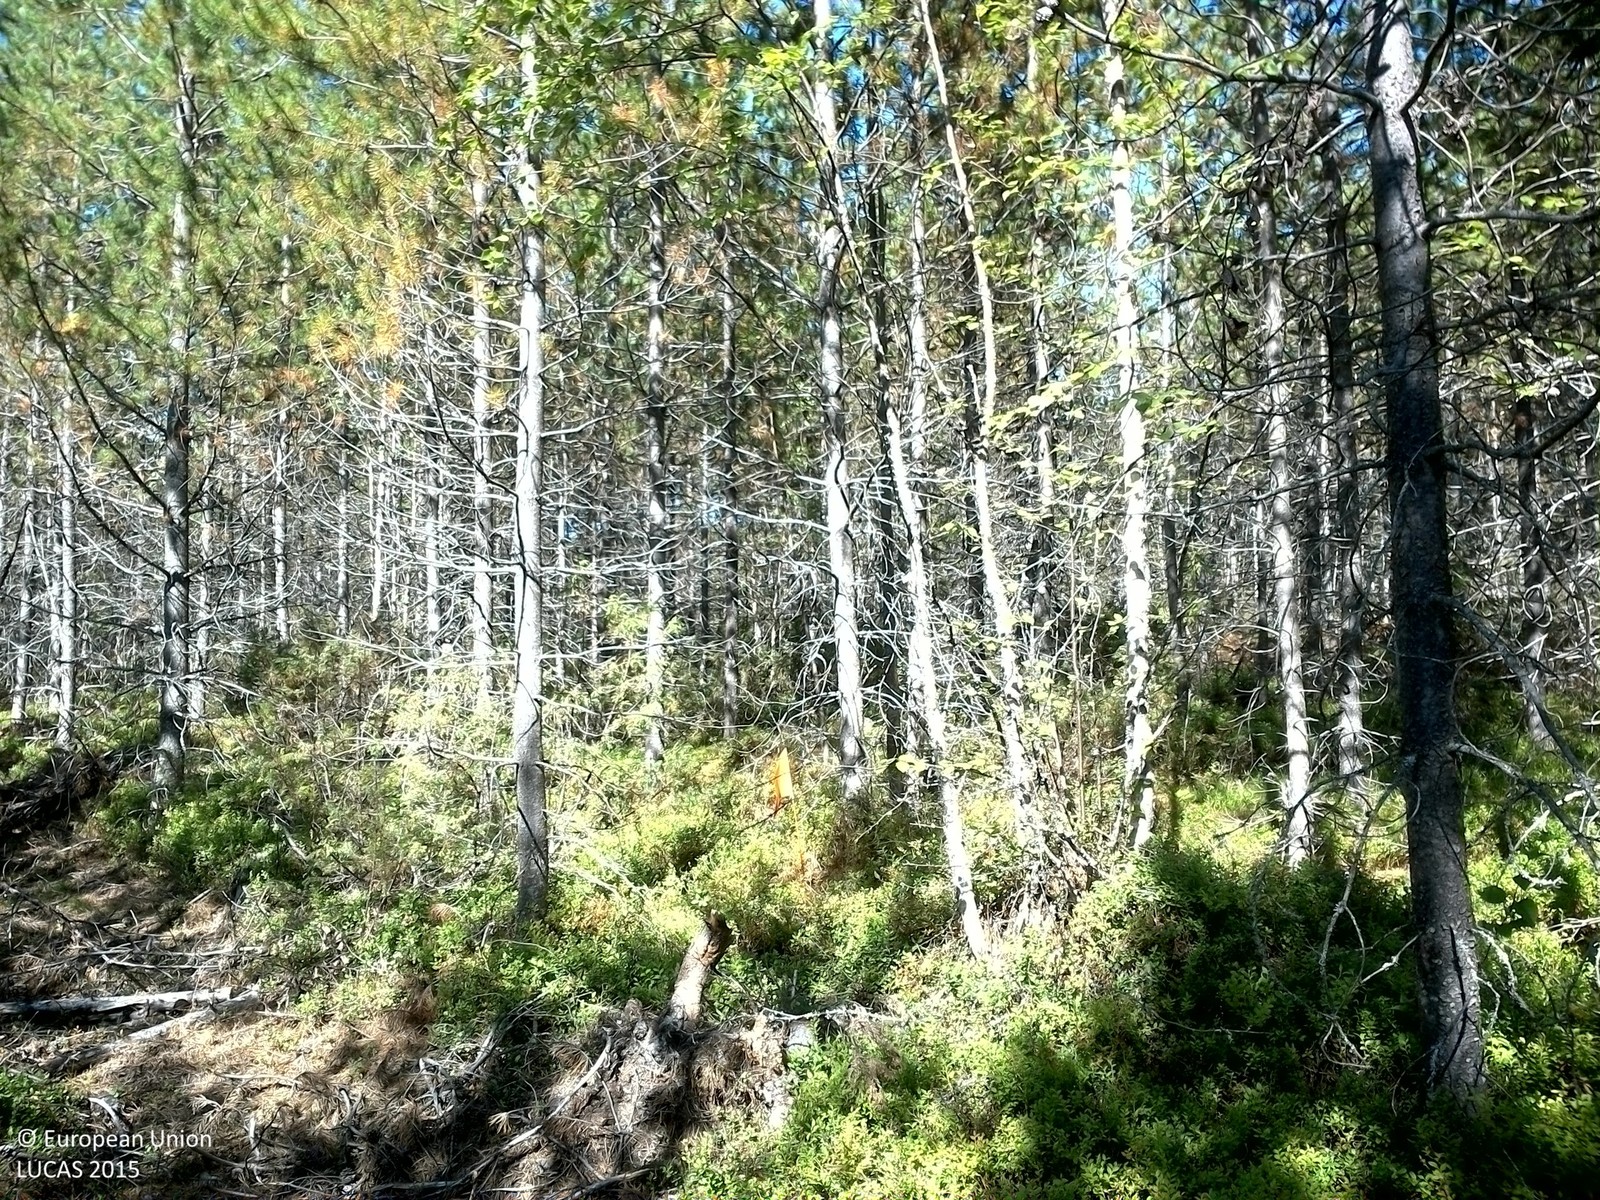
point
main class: Woodland
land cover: Pine dominated coniferous woodland
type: exotic forest
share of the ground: > 75 %
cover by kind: coniferous forest trees 85 %, shrubs 15 %
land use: Forestry
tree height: < 5 m
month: August
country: SE
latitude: 63.6720
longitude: 17.5919
